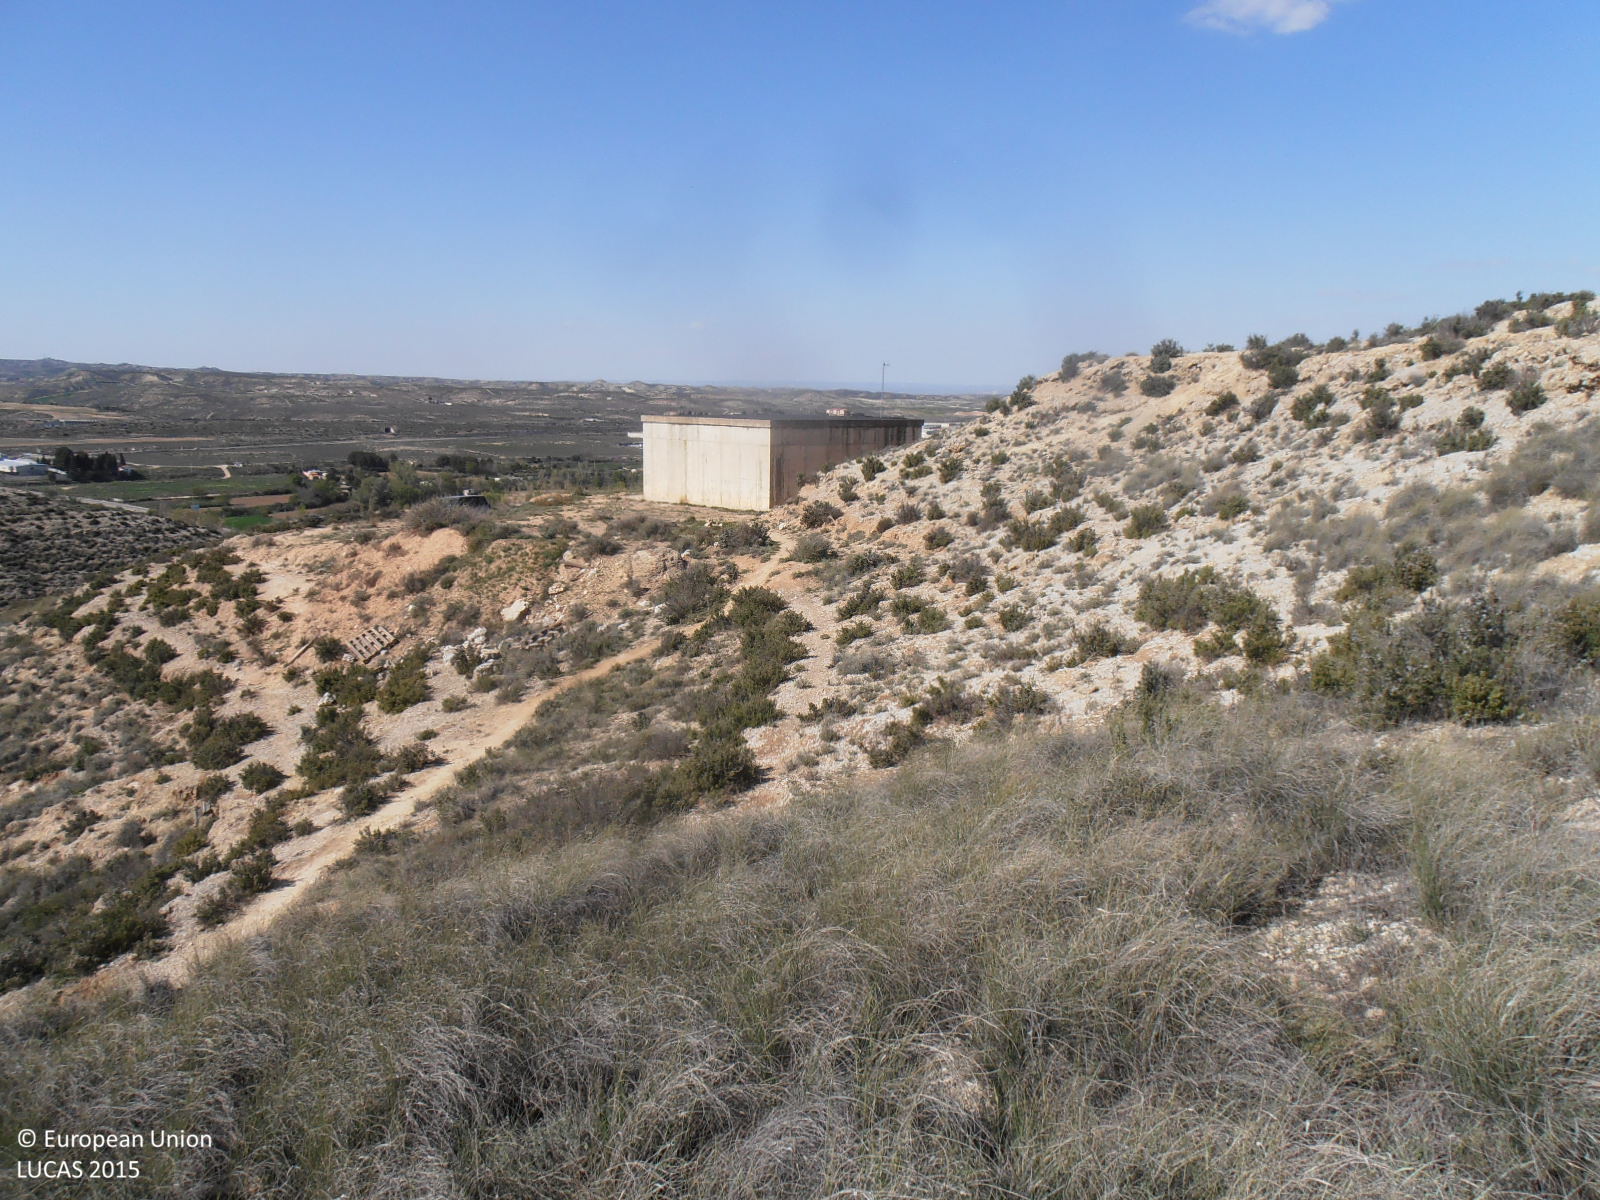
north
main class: Shrubland
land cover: Shrubland without tree cover
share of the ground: 50 - 75 %
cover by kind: shrubs 55 %, consolidated bare surface 45 %
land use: Semi-natural and natural areas not in use
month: April
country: ES
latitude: 41.5467
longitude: -0.9666
